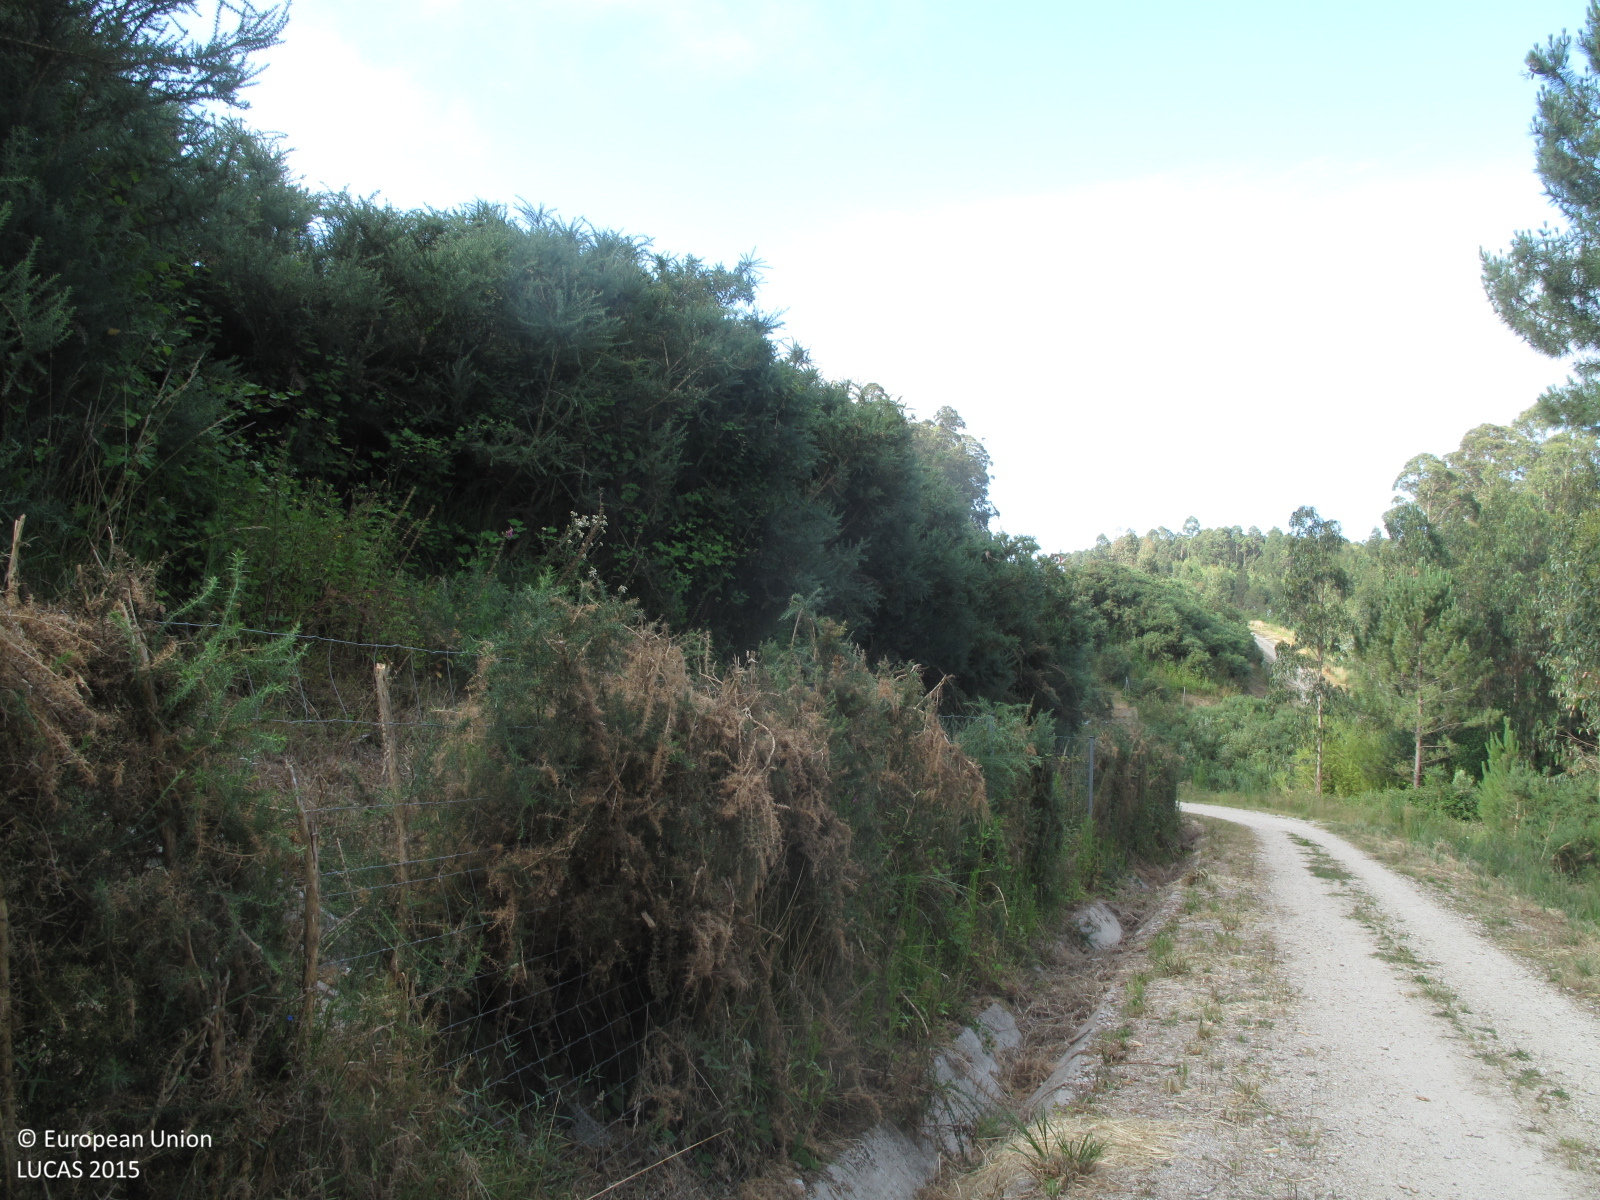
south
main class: Shrubland
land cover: Shrubland without tree cover
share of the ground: 50 - 75 %
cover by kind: shrubs 60 %, herbaceous plants 40 %
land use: Road transport
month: July
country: ES
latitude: 43.3693
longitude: -8.3066
